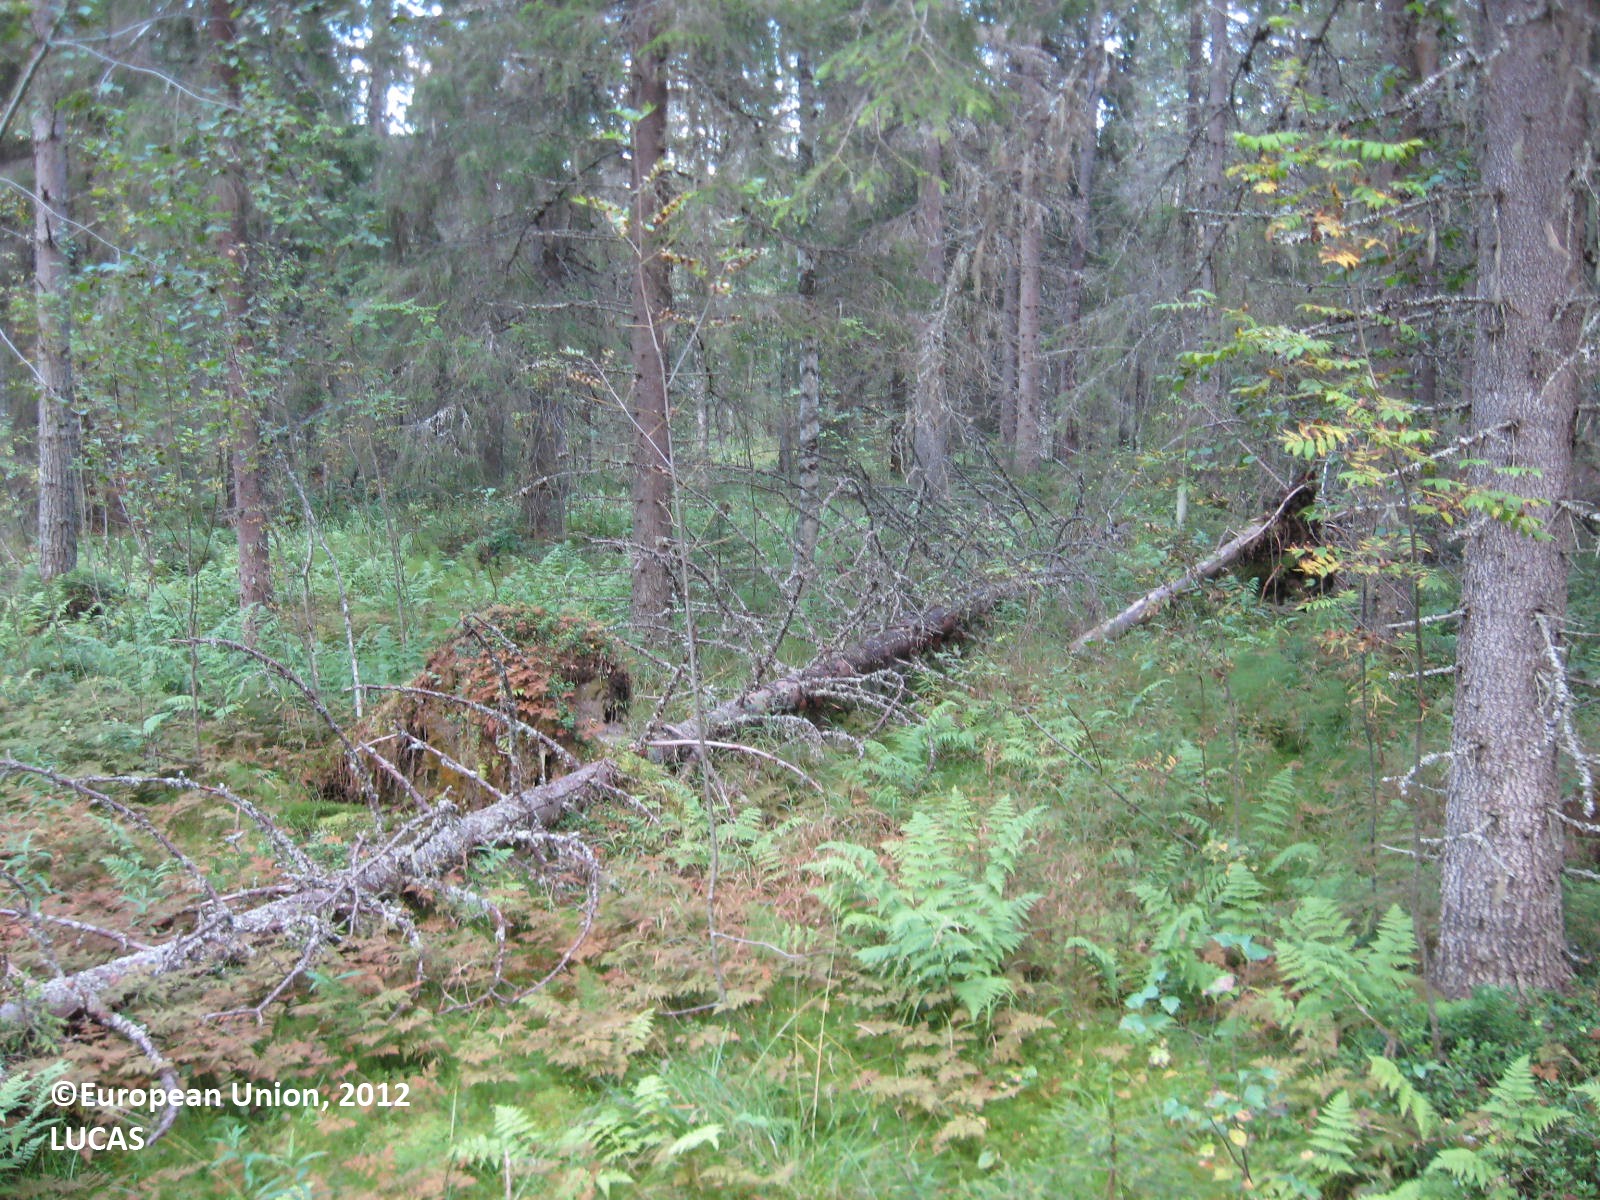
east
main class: Woodland
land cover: Other coniferous woodland
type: boreal forest
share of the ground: 50 - 75 %
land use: Forestry
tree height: > 5 m
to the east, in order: Other coniferous woodland; Ditches and canals; Other coniferous woodland
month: August
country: FI
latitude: 63.7344
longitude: 29.3162
